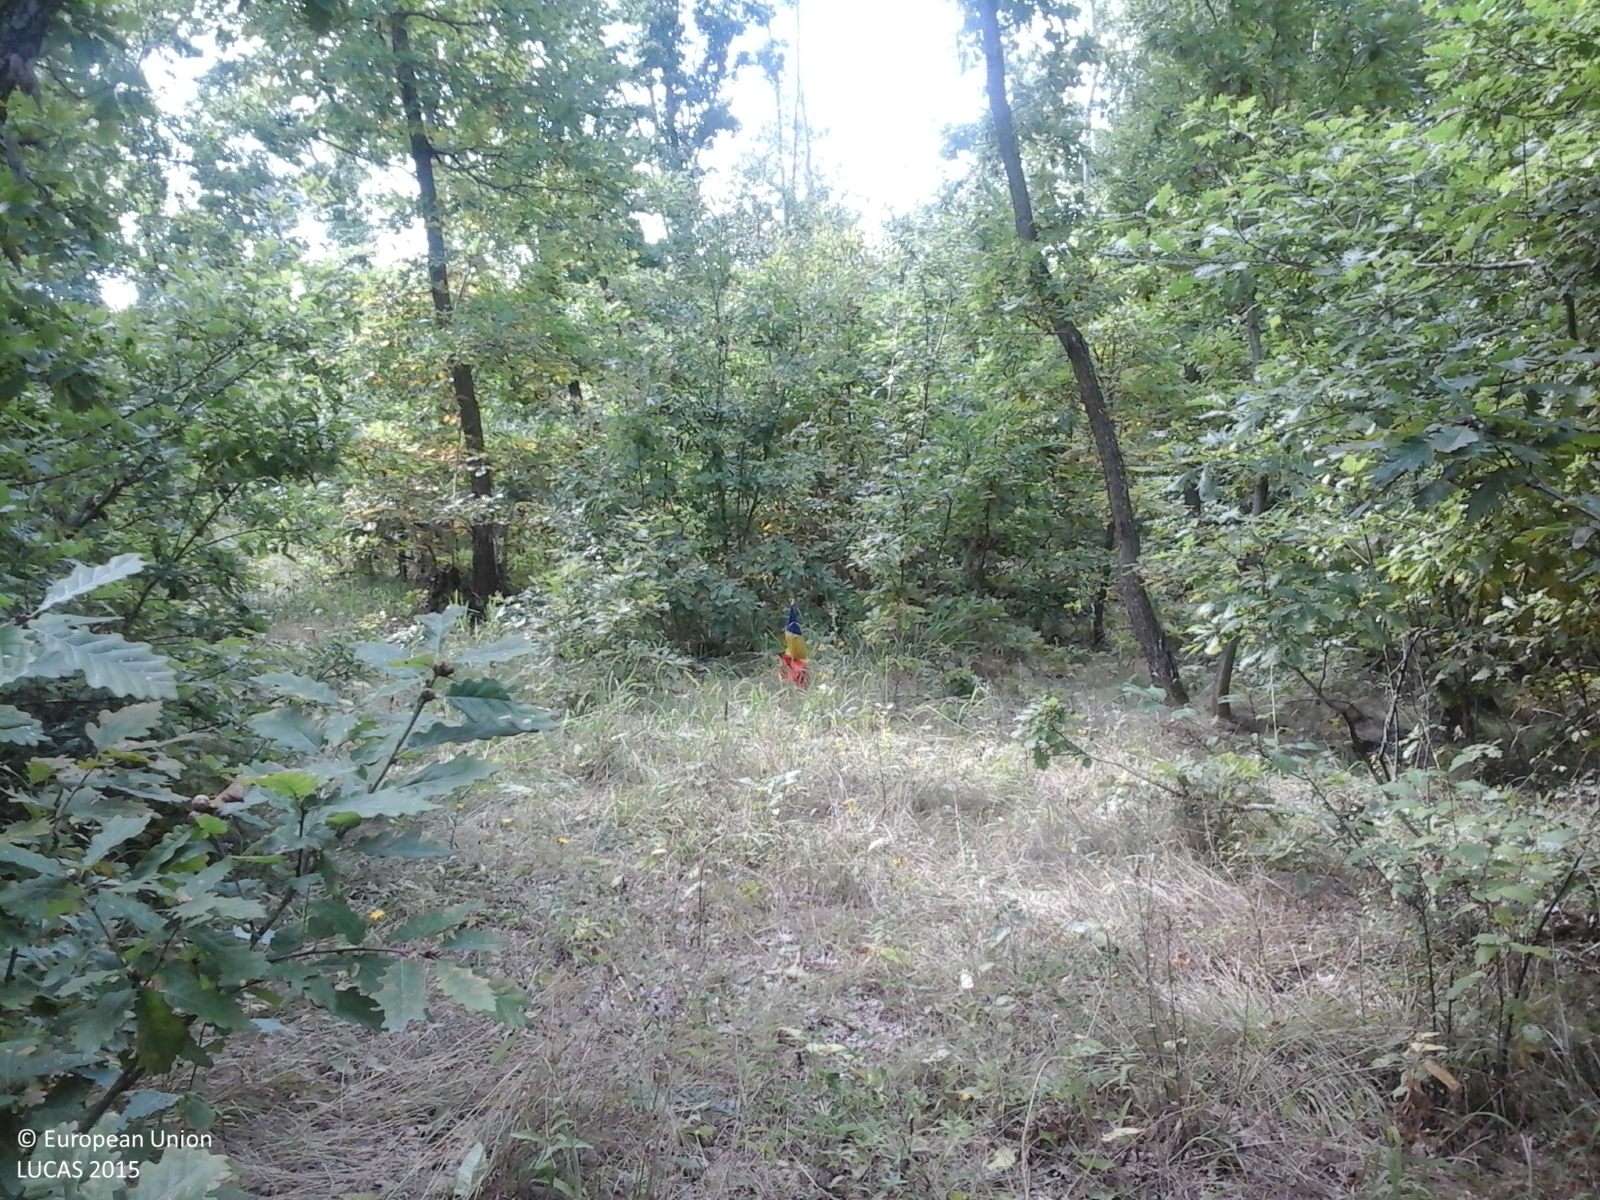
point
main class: Woodland
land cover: Broadleaved woodland
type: acidophilous oak and oak-birch forest
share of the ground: > 75 %
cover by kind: broadleaved forest trees 100 %
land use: Forestry
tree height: > 5 m
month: September
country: RO
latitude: 46.6566
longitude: 23.5157
